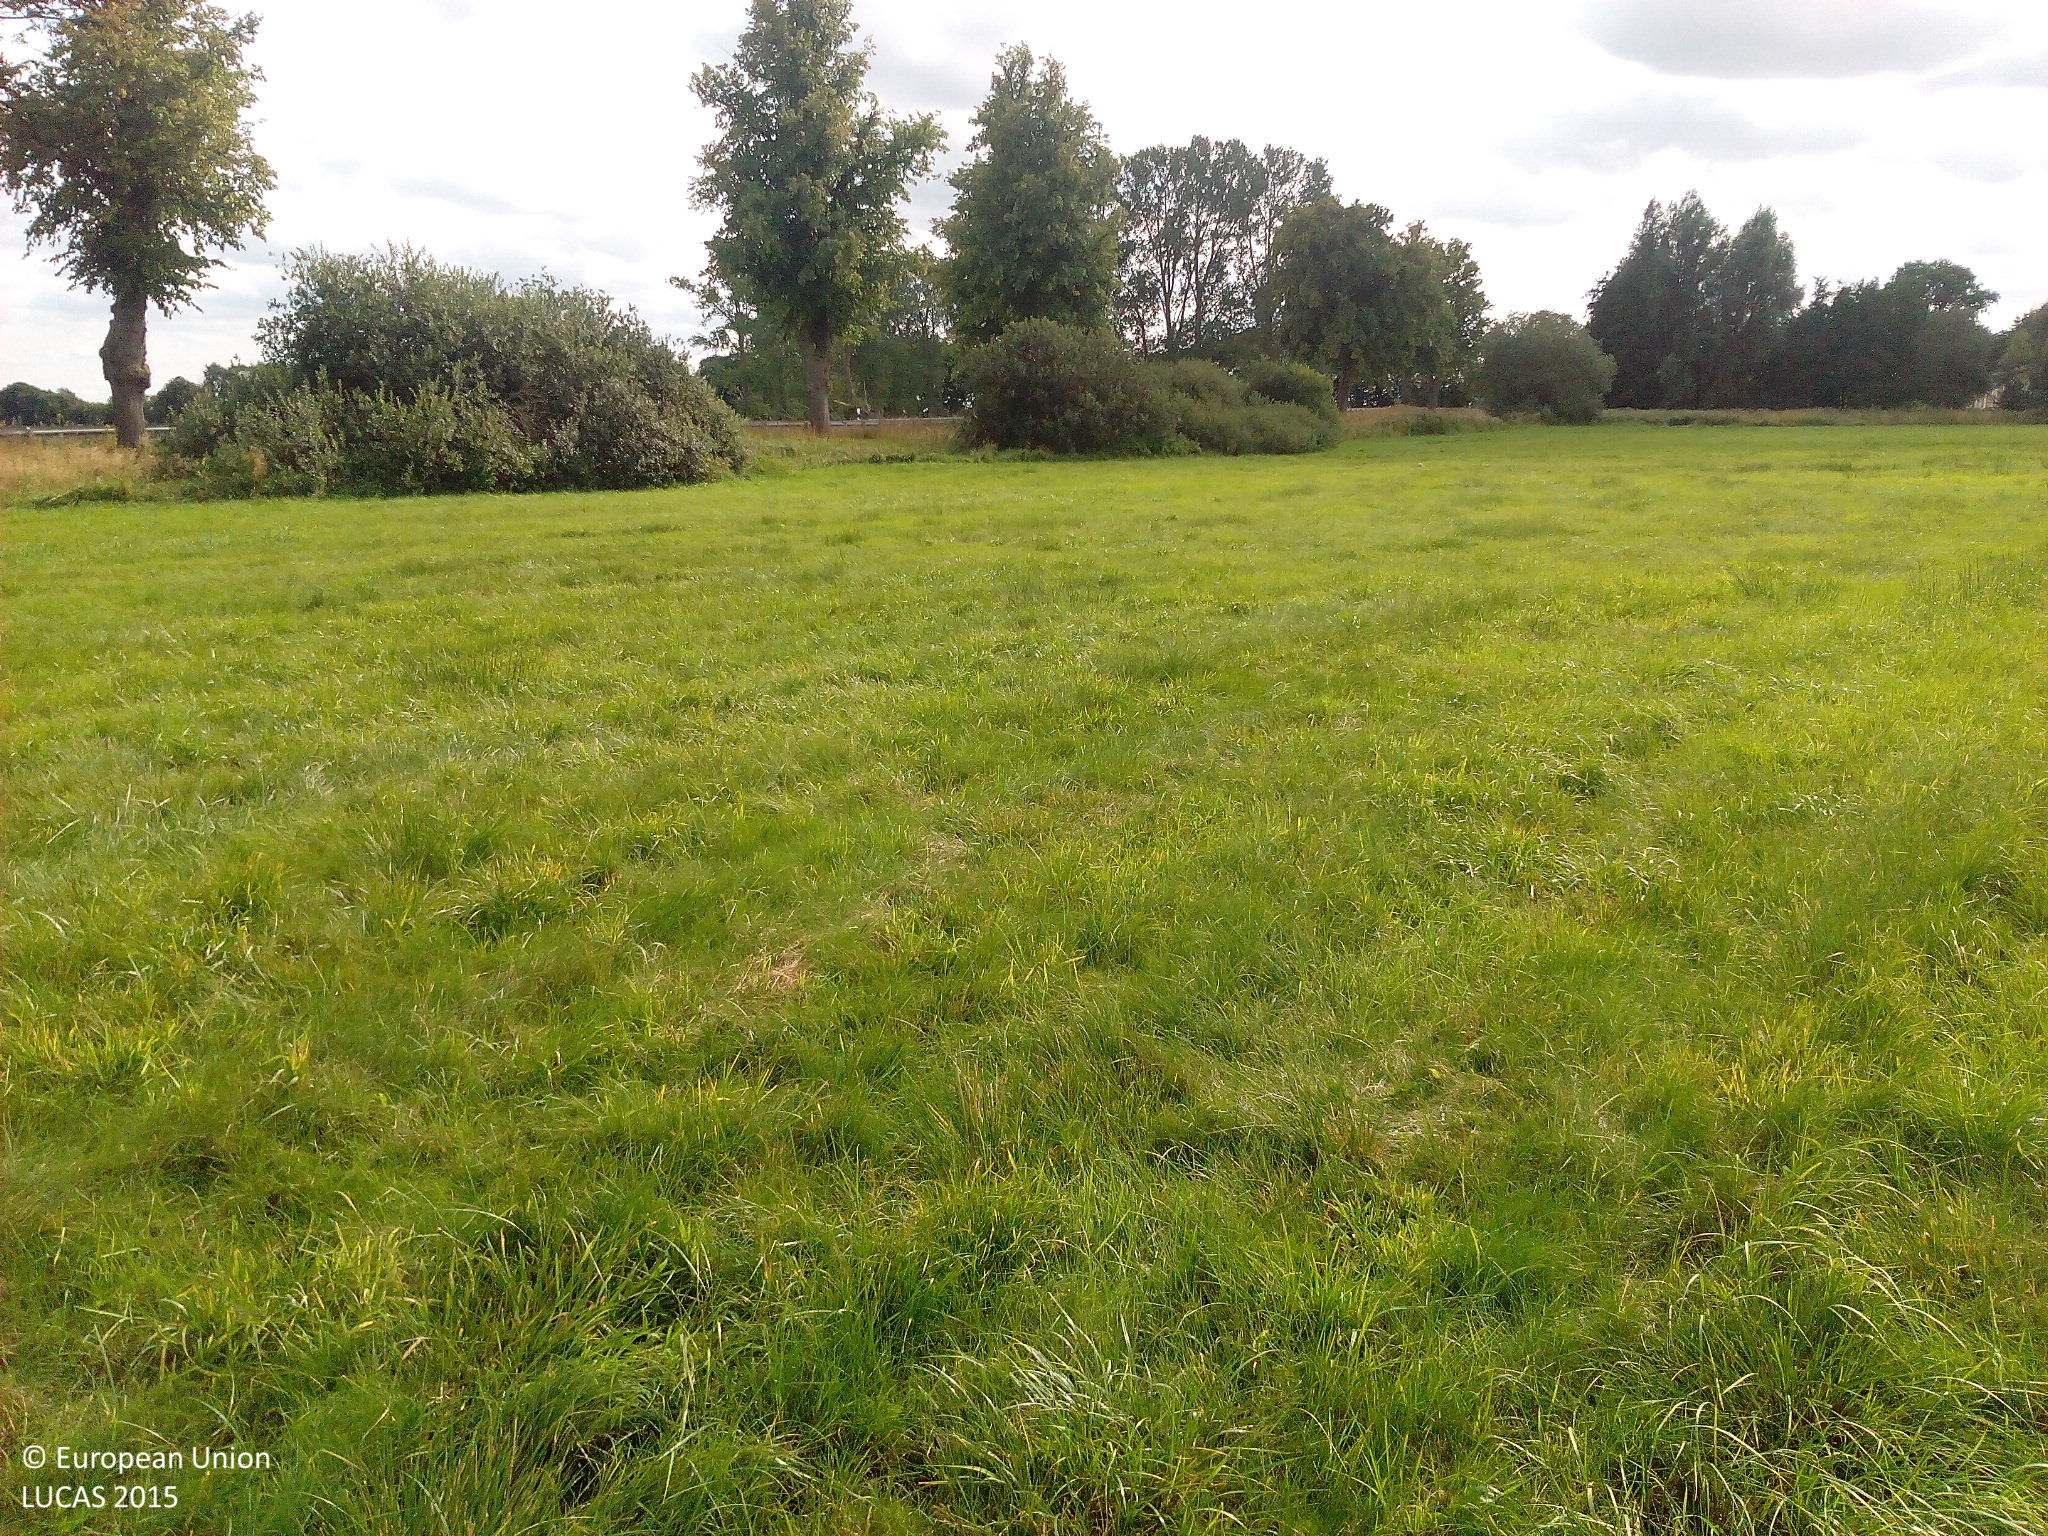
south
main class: Grassland
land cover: Grassland without tree/shrub cover
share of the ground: > 75 %
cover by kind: herbaceous plants 100 %
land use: Agriculture (excluding fallow land and kitchen gardens)
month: August
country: DE
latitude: 53.9654
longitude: 12.6972
